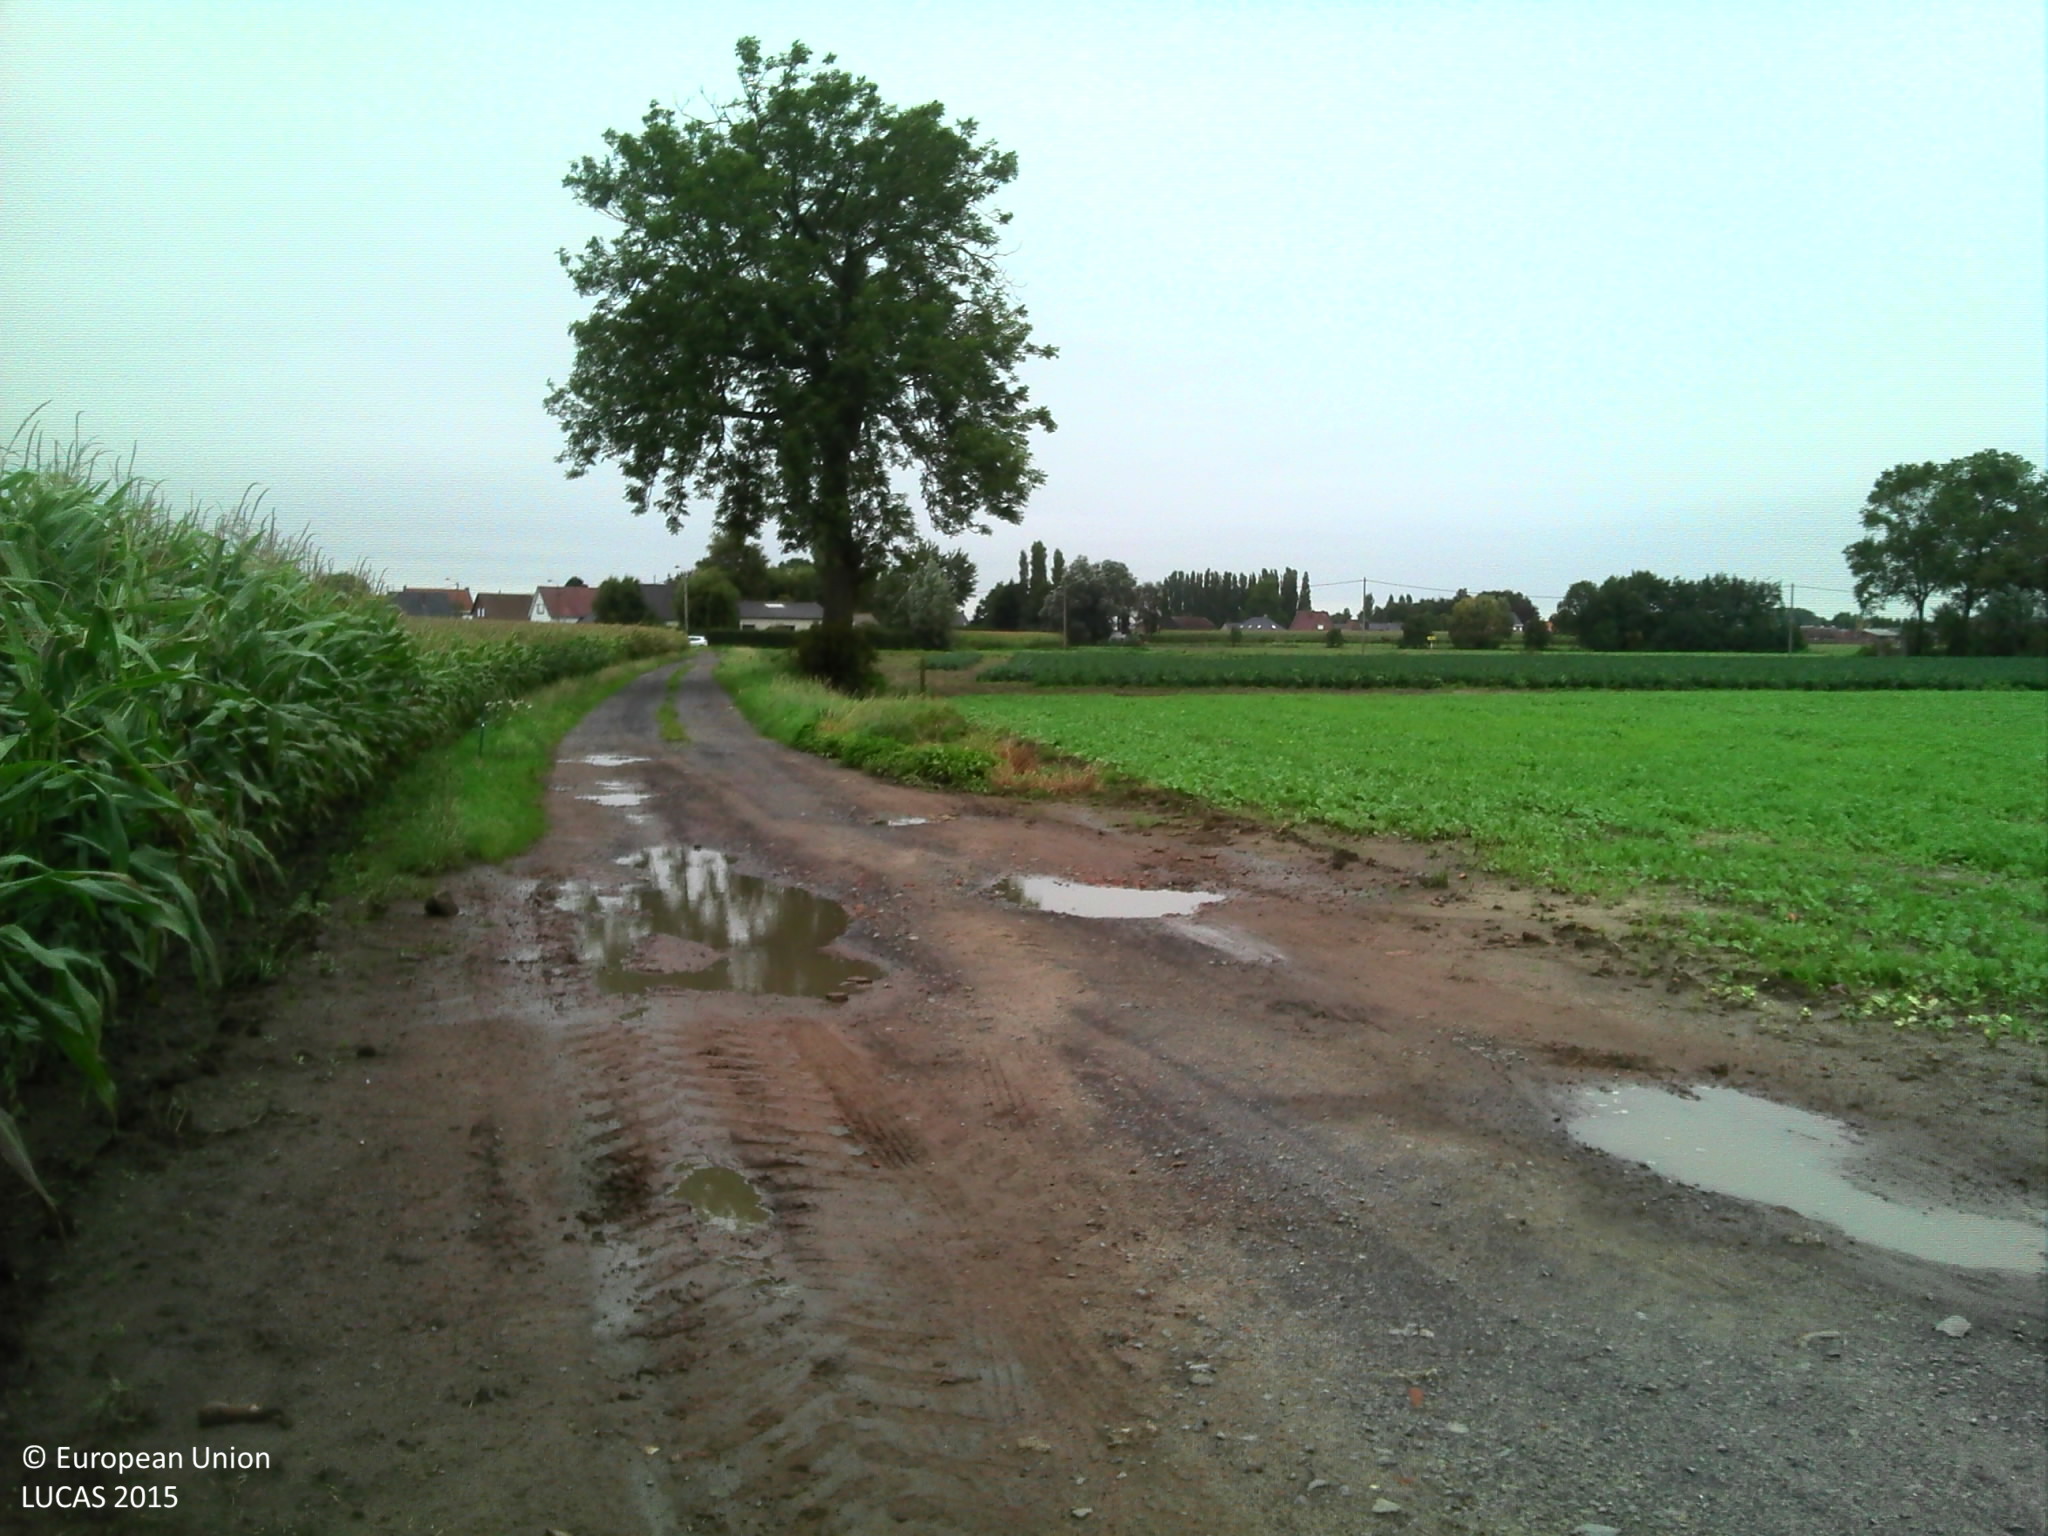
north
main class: Cropland
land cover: Maize
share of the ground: > 75 %
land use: Agriculture (excluding fallow land and kitchen gardens)
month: September
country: BE
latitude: 51.0851
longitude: 2.9516
